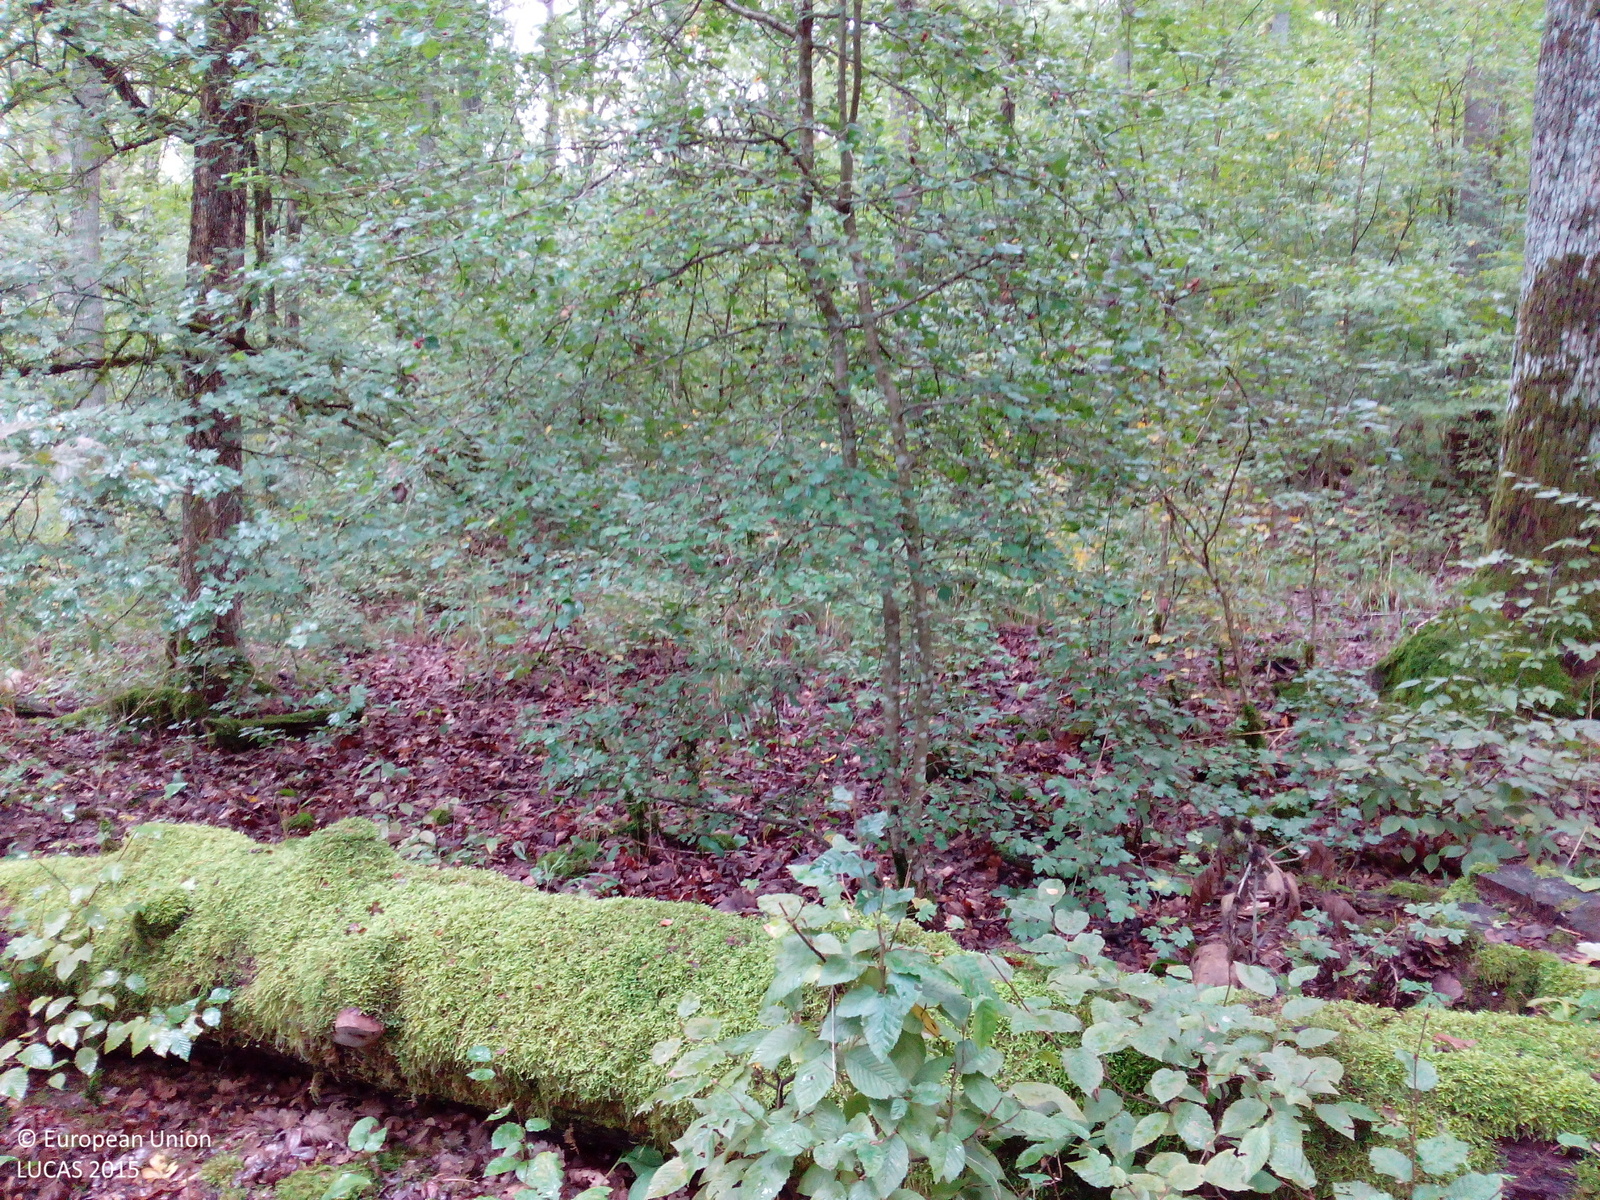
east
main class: Woodland
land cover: Broadleaved woodland
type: acidophilous oak and oak-birch forest
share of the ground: > 75 %
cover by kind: broadleaved forest trees 95 %, shrubs 5 %
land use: Forestry
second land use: Amenities, museums, leisure
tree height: > 5 m
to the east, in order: Broadleaved woodland; Tracks; Broadleaved woodland; Tracks; Broadleaved woodland; Spruce dominated mixed woodland; Spruce dominated coniferous woodland
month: September
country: DE
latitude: 49.9504
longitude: 9.9582
